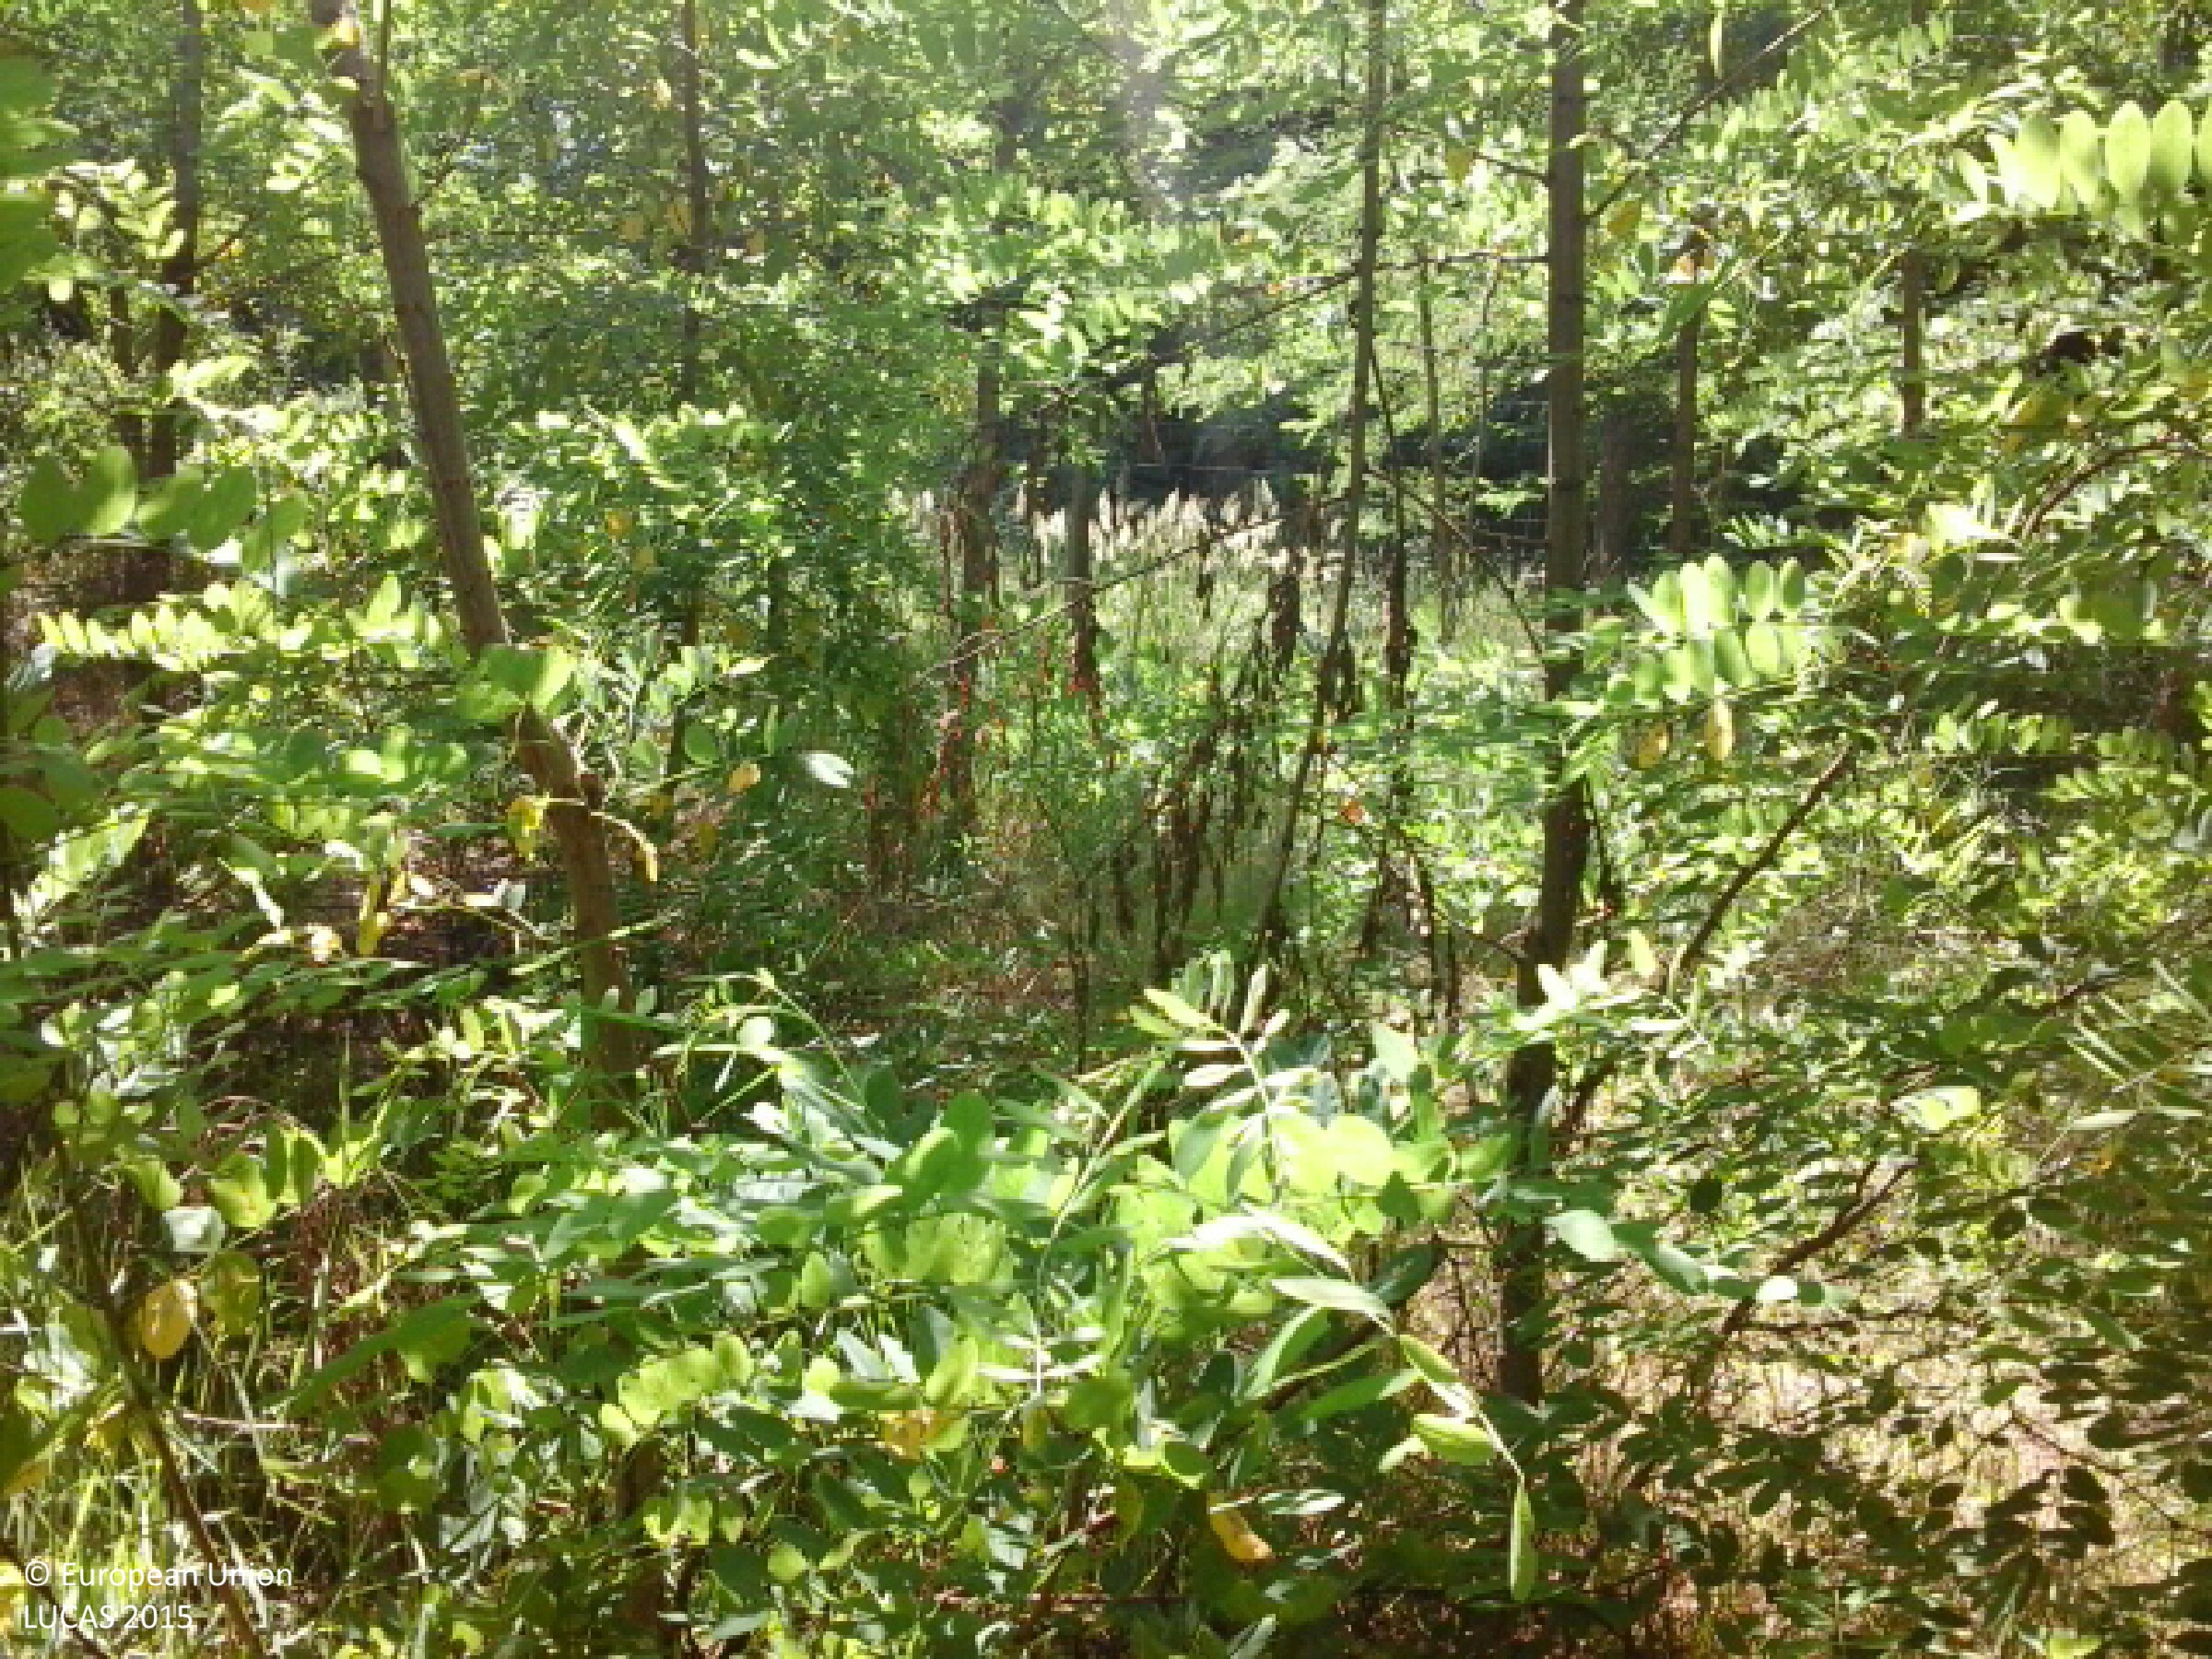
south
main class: Woodland
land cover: Broadleaved woodland
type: exotic forest
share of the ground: > 75 %
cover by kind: broadleaved forest trees 90 %, herbaceous plants 10 %
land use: Forestry
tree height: < 5 m
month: July
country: HU
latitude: 48.0055
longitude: 22.2943
